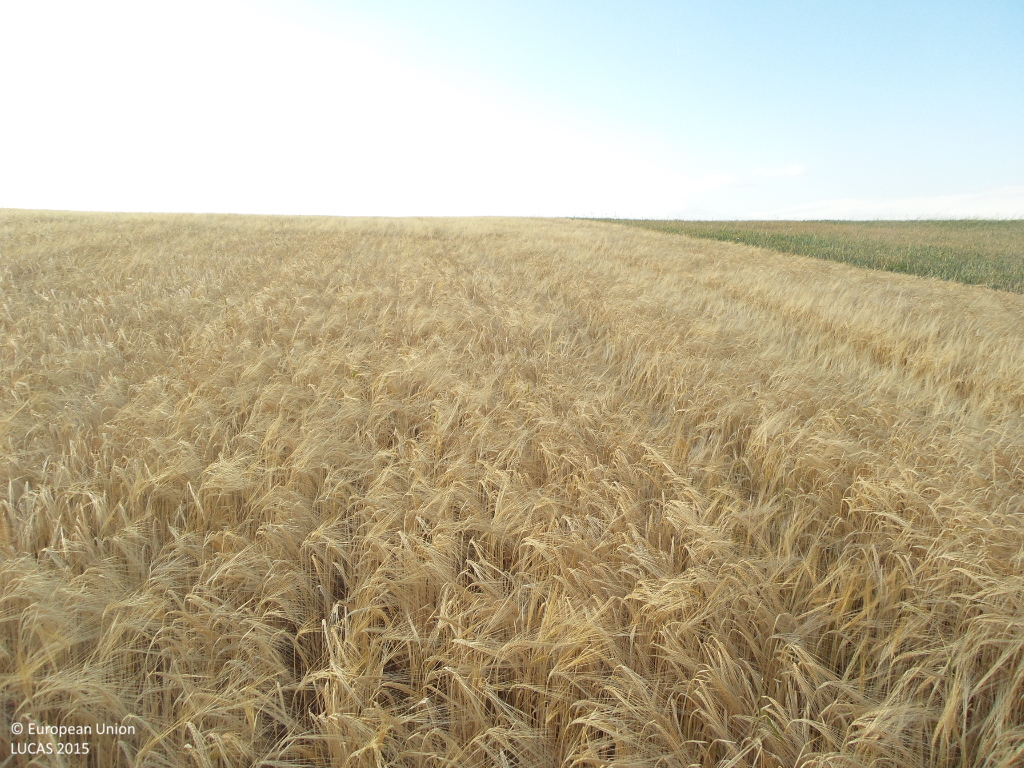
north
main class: Cropland
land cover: Barley
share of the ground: > 75 %
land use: Agriculture (excluding fallow land and kitchen gardens)
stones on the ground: < 10 %
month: June
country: ES
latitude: 41.4694
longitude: -3.1059
